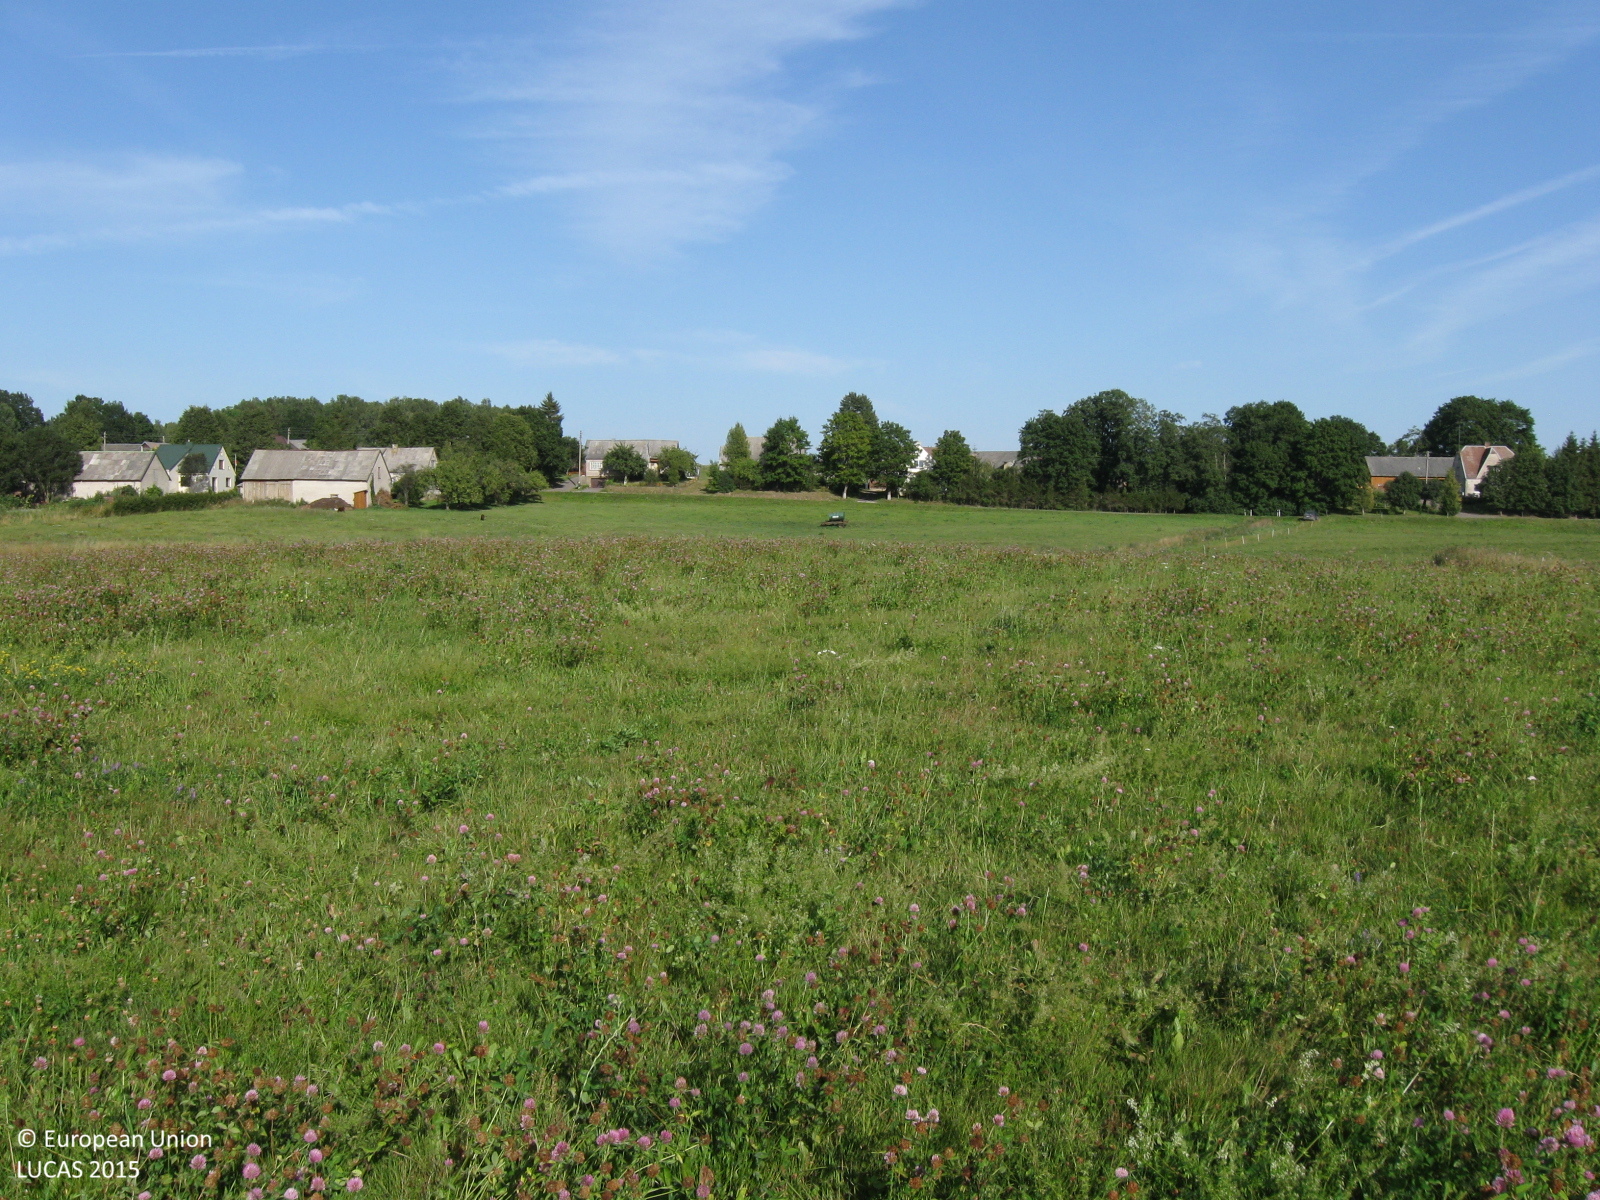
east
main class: Grassland
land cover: Grassland without tree/shrub cover
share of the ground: > 75 %
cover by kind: herbaceous plants 100 %
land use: Agriculture (excluding fallow land and kitchen gardens)
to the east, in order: Grassland without tree/shrub cover; Tracks; Spontaneously vegetated surfaces; Ditches and canals; Spontaneously vegetated surfaces; Grassland without tree/shrub cover
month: August
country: LT
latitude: 55.4748
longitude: 22.5765
